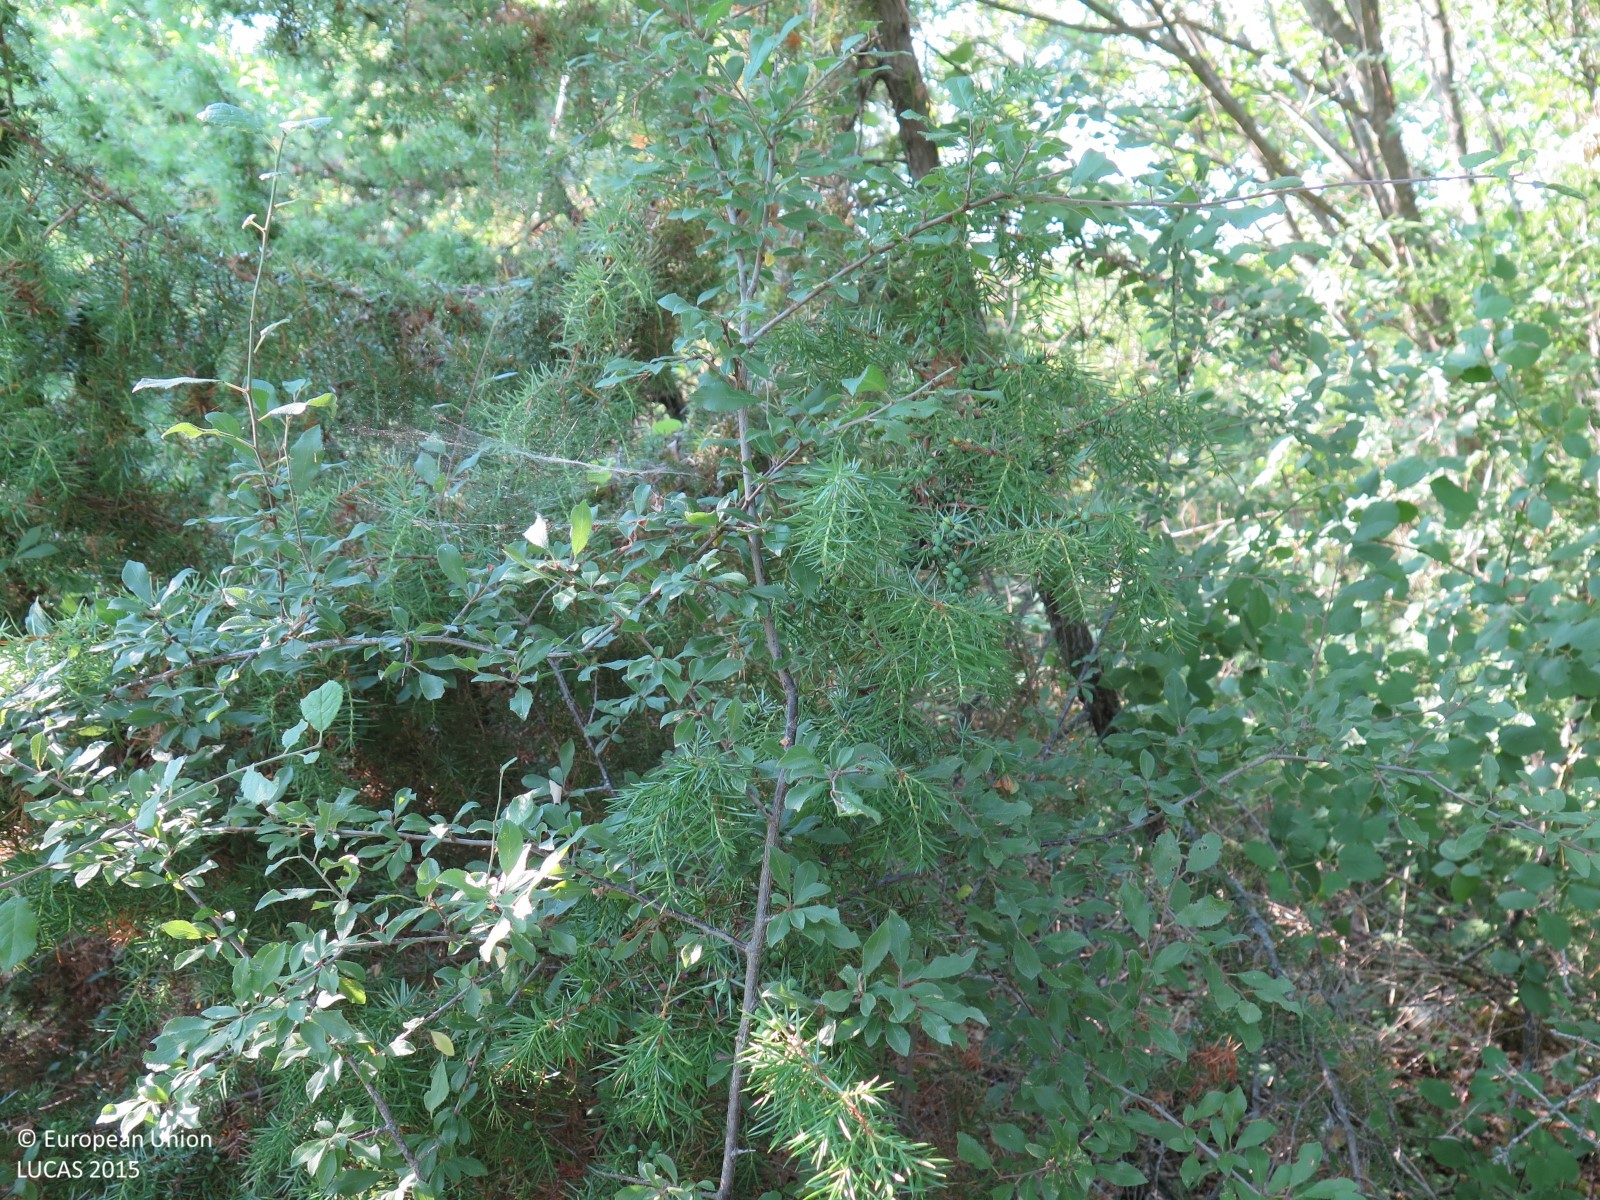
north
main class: Shrubland
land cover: Shrubland with sparse tree cover
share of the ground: > 75 %
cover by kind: shrubs 90 %, broadleaved forest trees 5 %, herbaceous plants 5 %
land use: Semi-natural and natural areas not in use
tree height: > 5 m
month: July
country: HR
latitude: 45.2375
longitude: 13.8037
